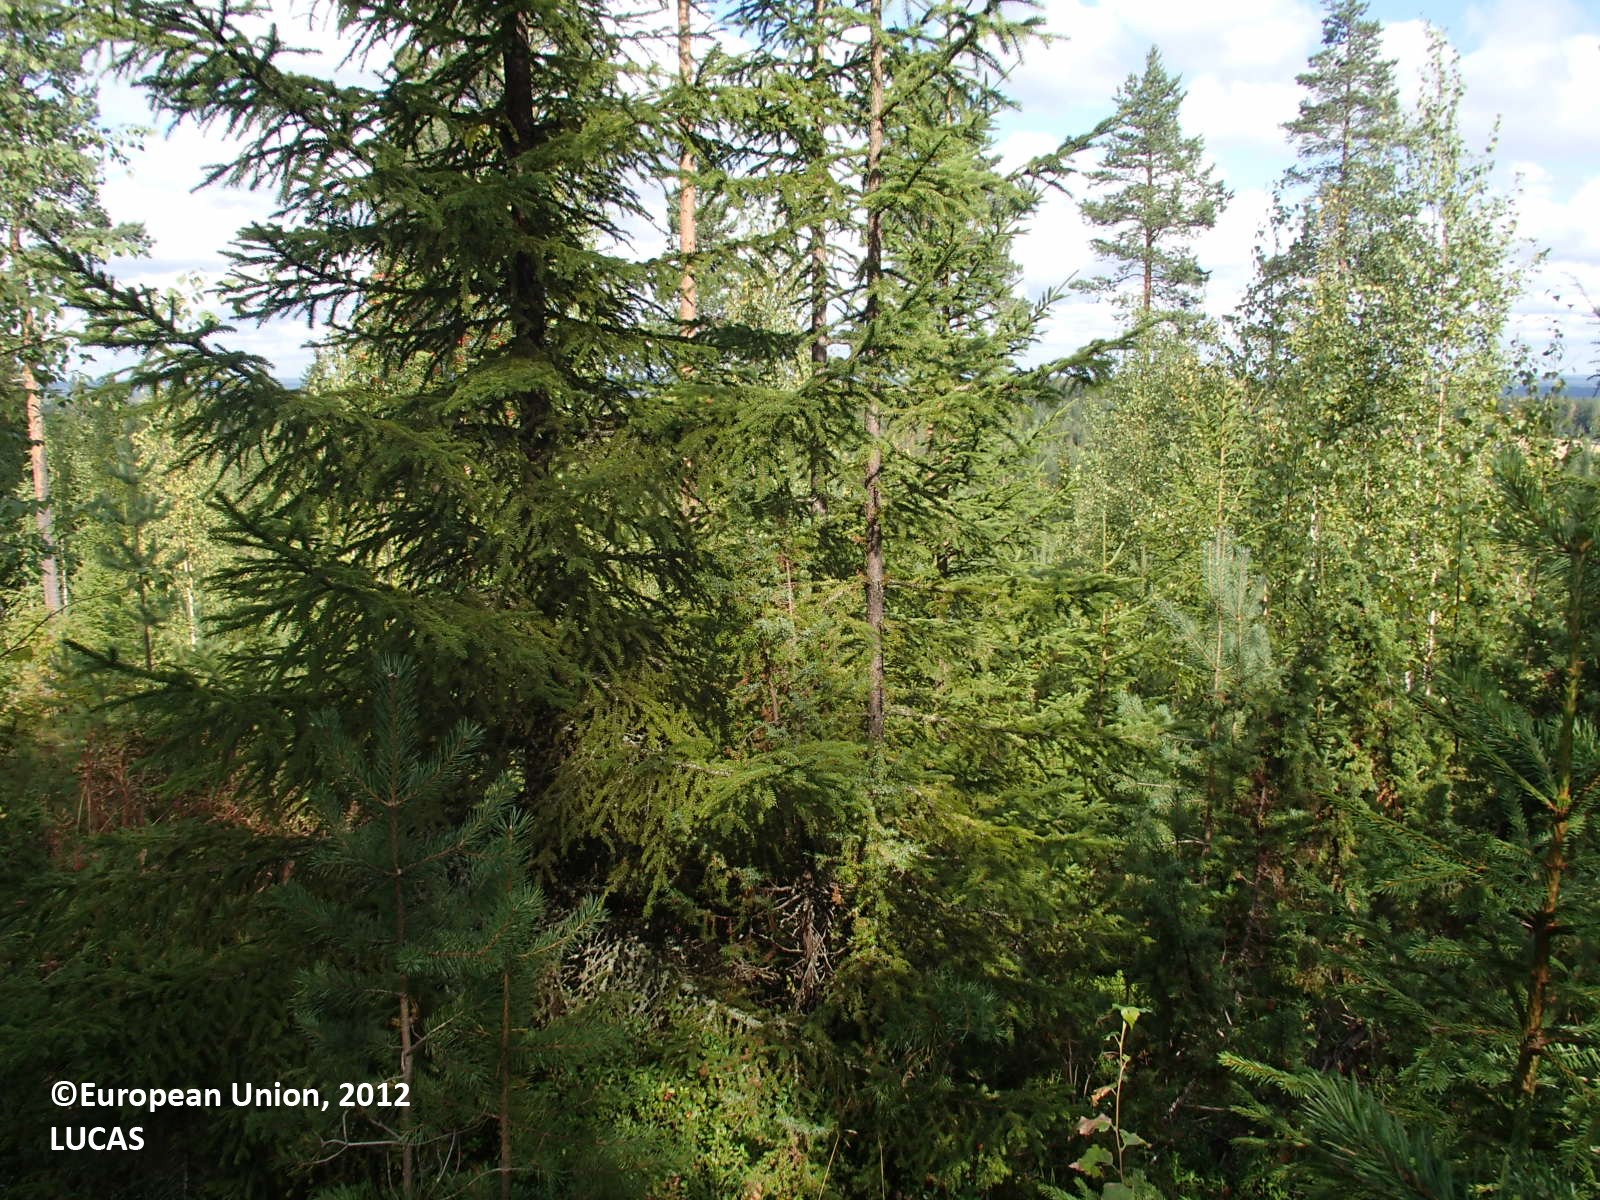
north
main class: Woodland
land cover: Other mixed woodland
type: boreal forest
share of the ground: 50 - 75 %
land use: Forestry
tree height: > 5 m
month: August
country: FI
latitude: 63.5161
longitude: 27.0866
